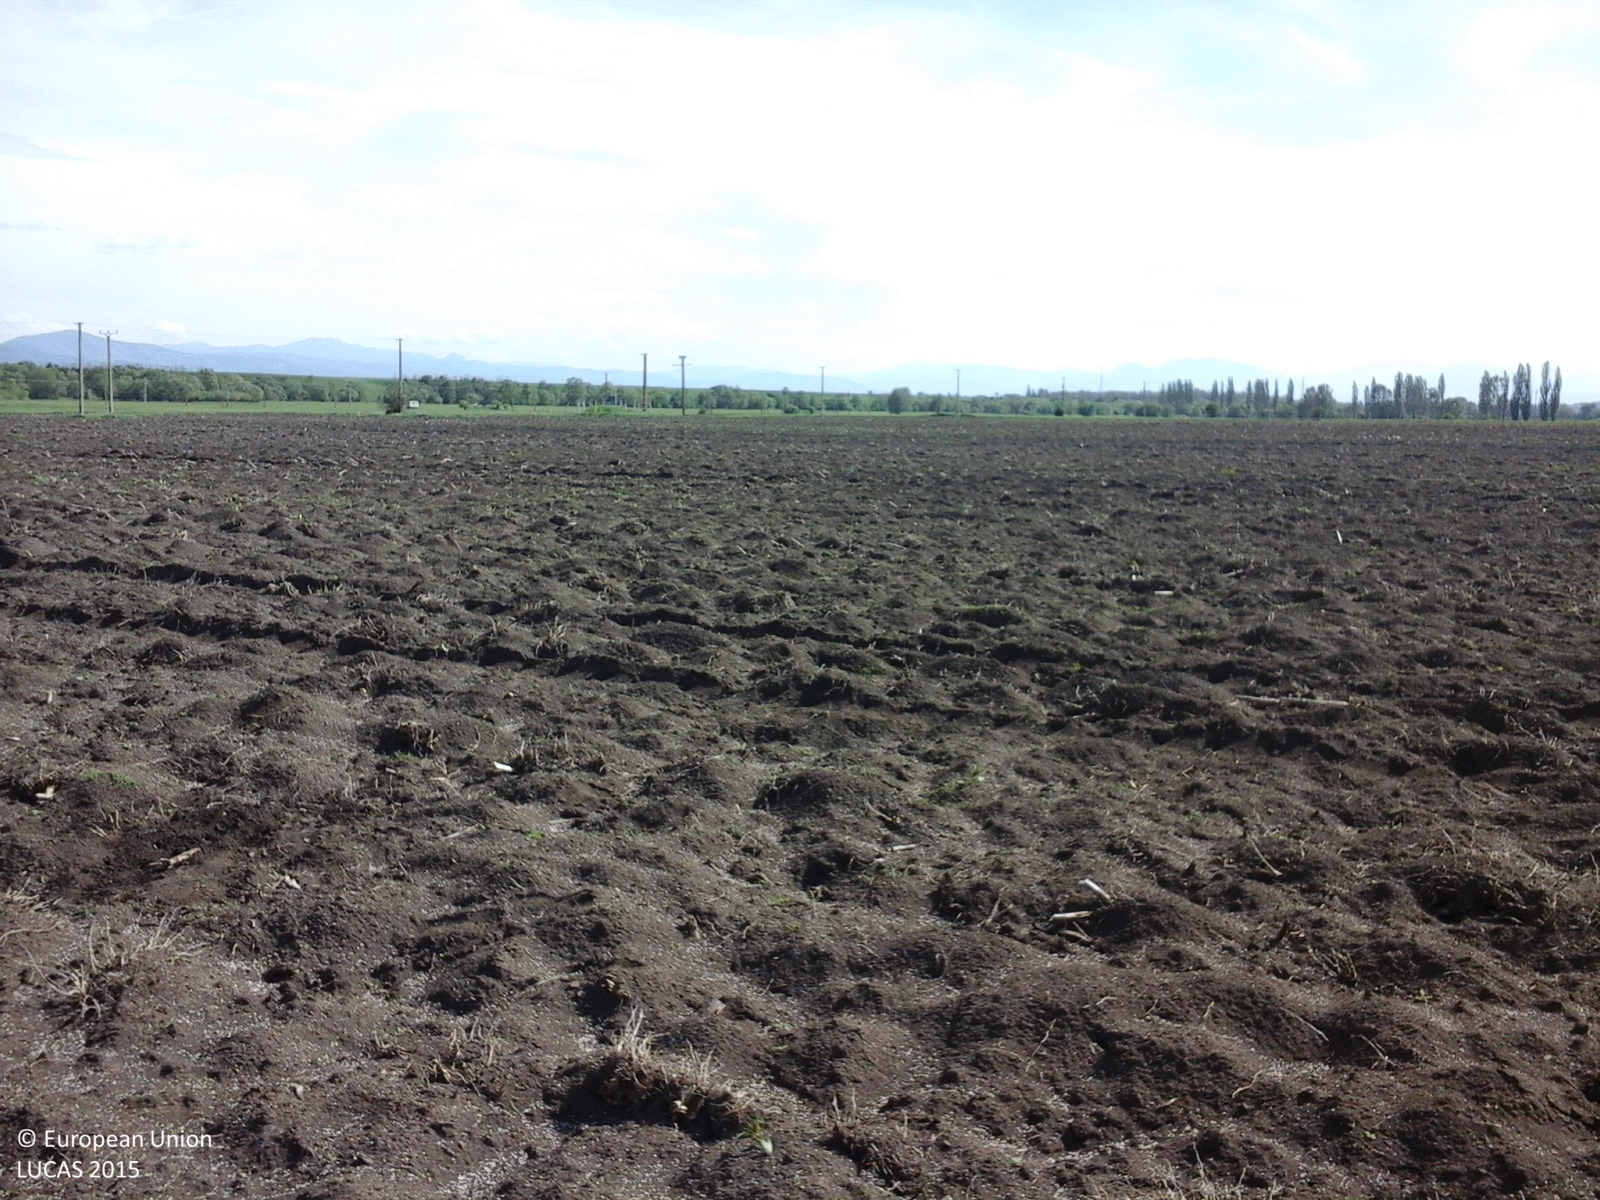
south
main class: Cropland
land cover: Maize
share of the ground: < 10 %
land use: Agriculture (excluding fallow land and kitchen gardens)
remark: Harvested field
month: May
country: RO
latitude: 45.8976
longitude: 25.8231
